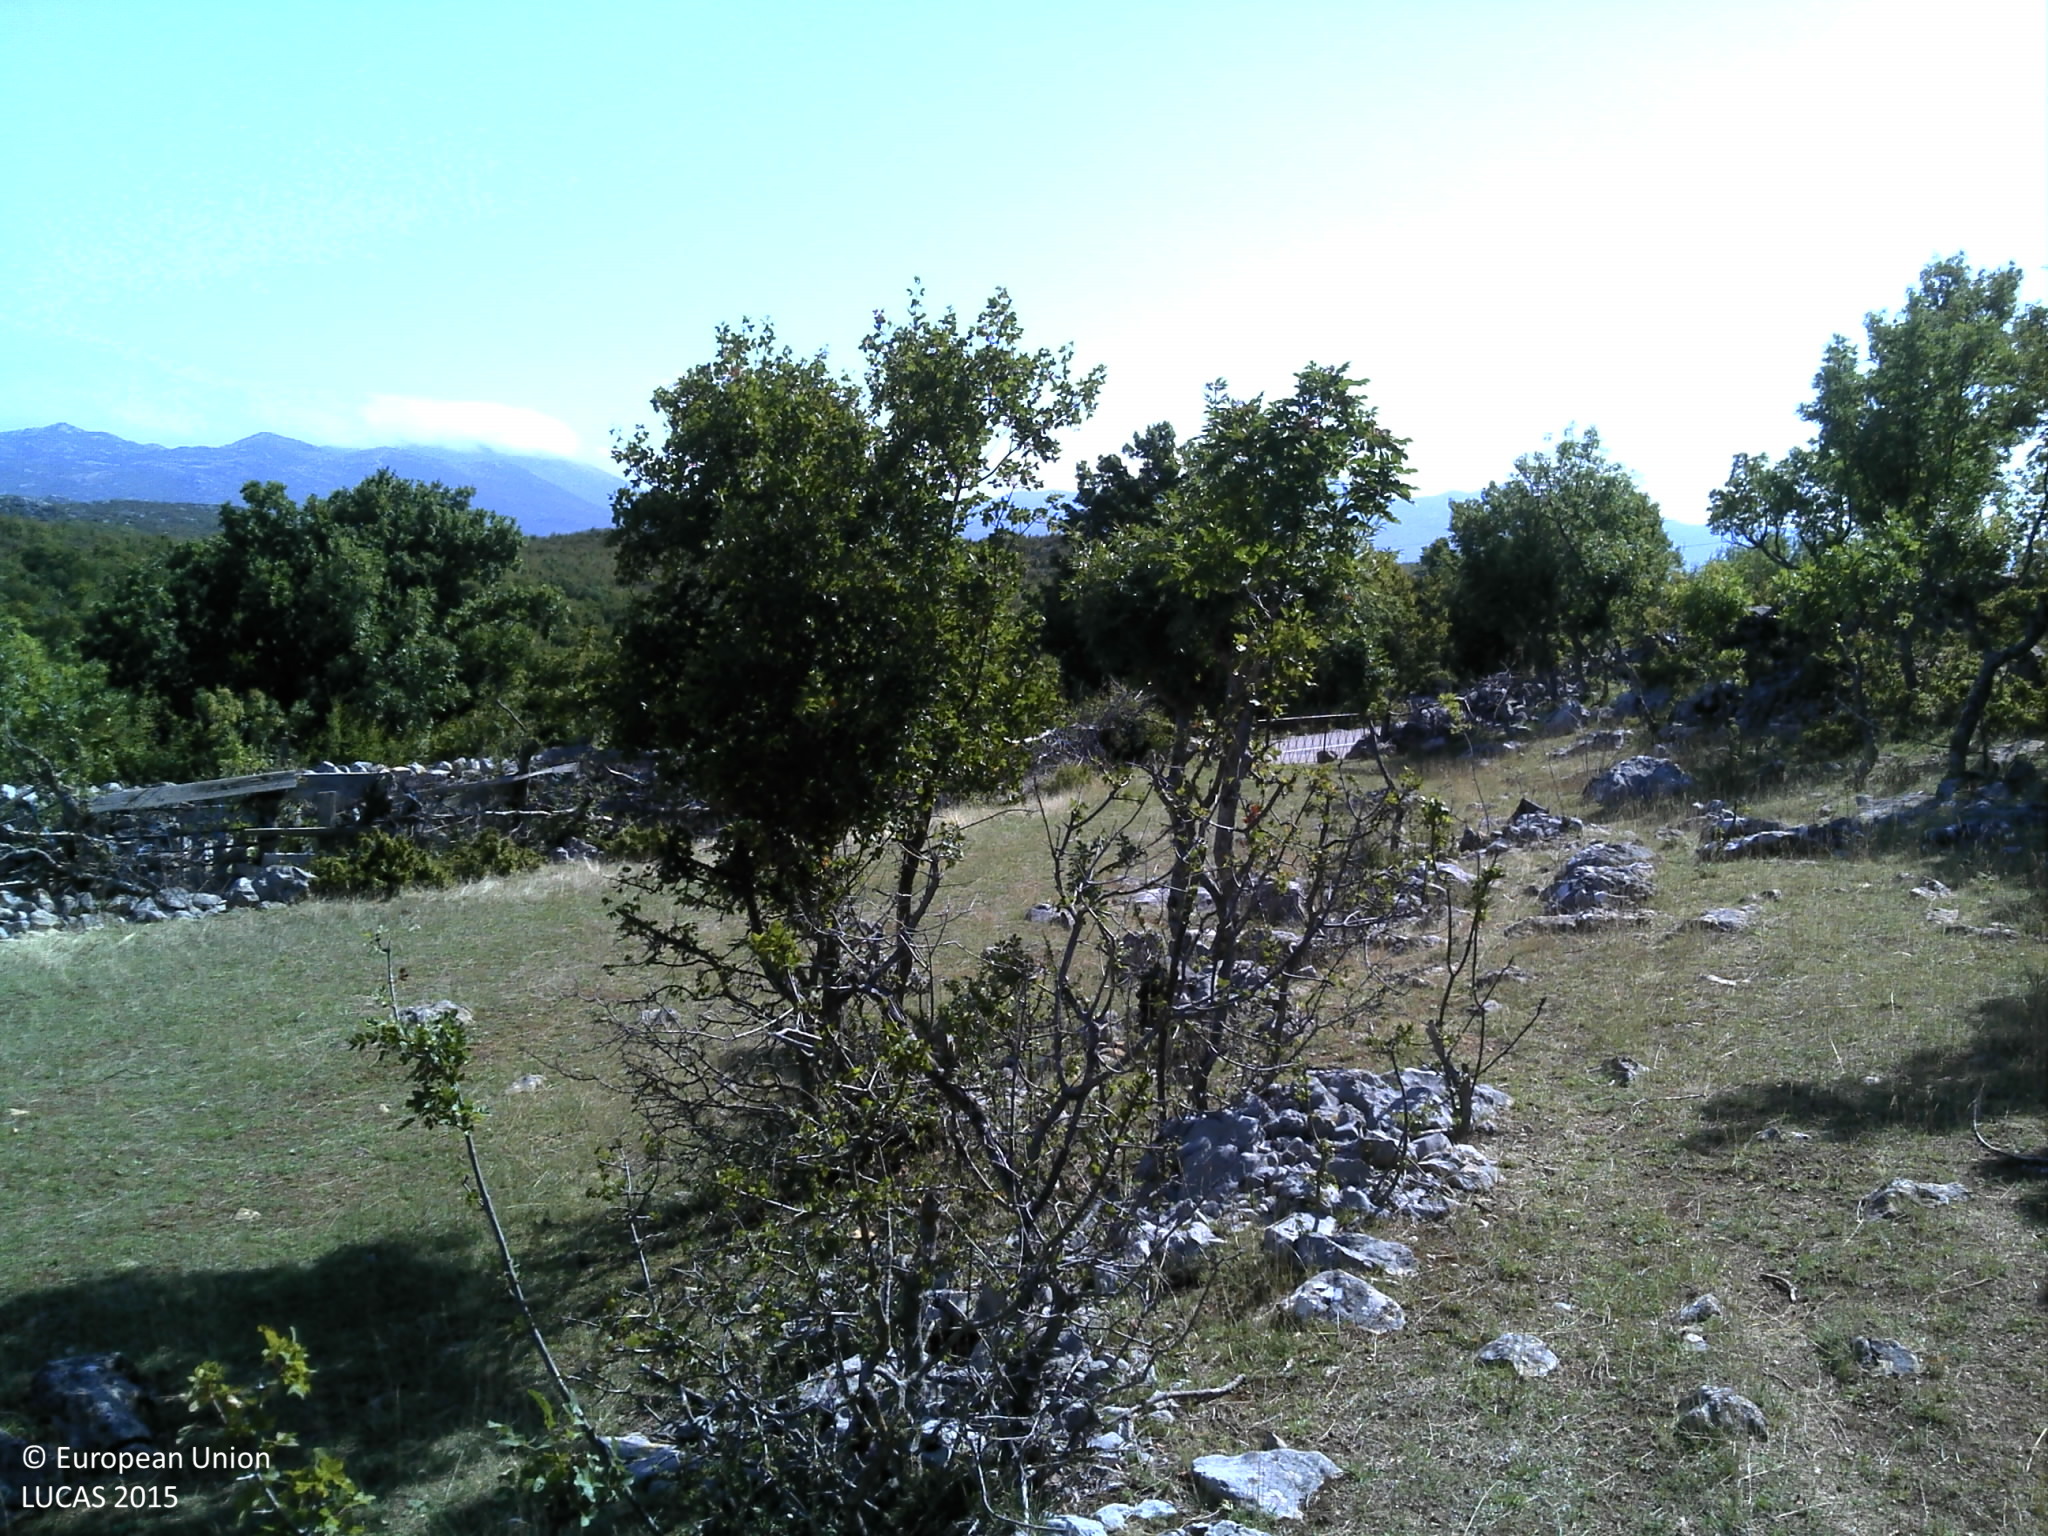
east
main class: Grassland
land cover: Grassland with sparse tree/shrub cover
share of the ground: 50 - 75 %
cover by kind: herbaceous plants 75 %, shrubs 10 %, broadleaved forest trees 5 %, consolidated bare surface 5 %, unconsolidated bare surface 5 %
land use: Agriculture (excluding fallow land and kitchen gardens)
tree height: > 5 m
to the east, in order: Grassland with sparse tree/shrub cover; Rock outcrops; Dry stone walls; Paved roads, cycling and walking lanes; Dry stone walls; Shrubland with sparse tree cover; Dry stone walls; Electric lines; Shrubland with sparse tree cover
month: August
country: HR
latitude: 44.2043
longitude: 15.8367
